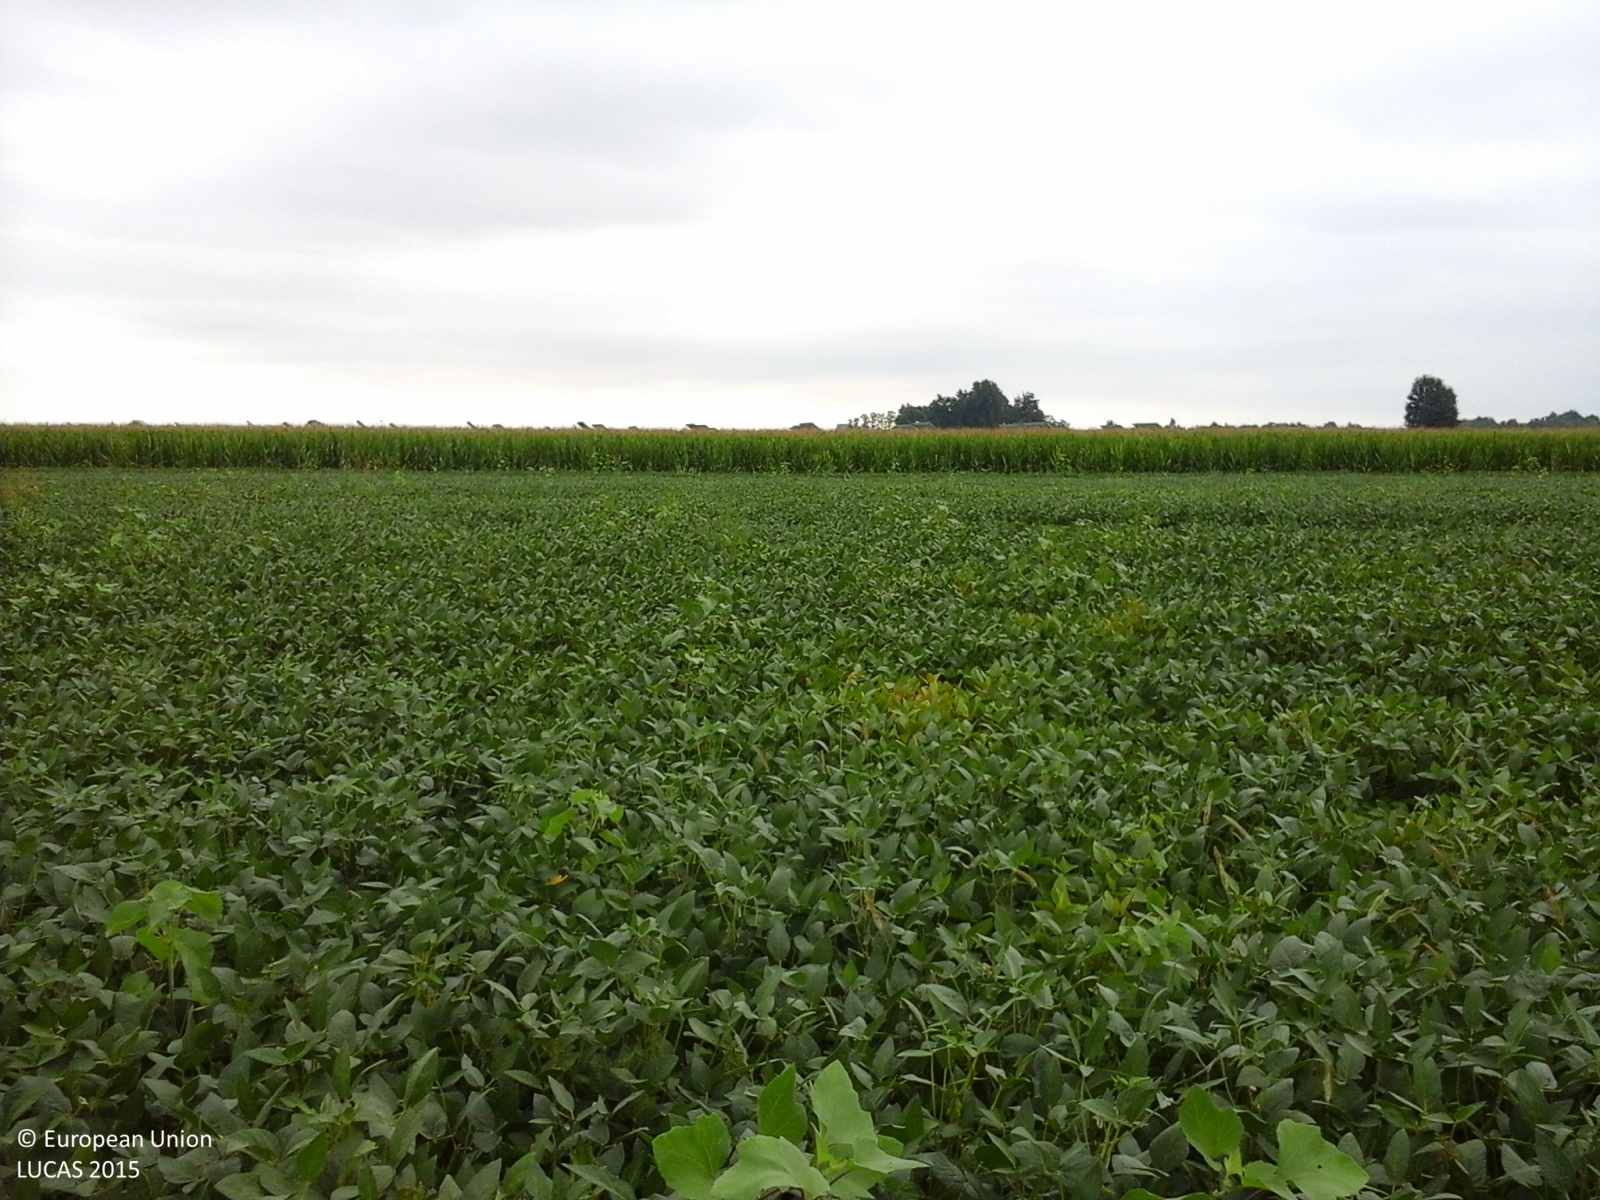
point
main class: Cropland
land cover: Soya
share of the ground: > 75 %
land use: Agriculture (excluding fallow land and kitchen gardens)
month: July
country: IT
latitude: 44.7950
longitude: 7.7416
